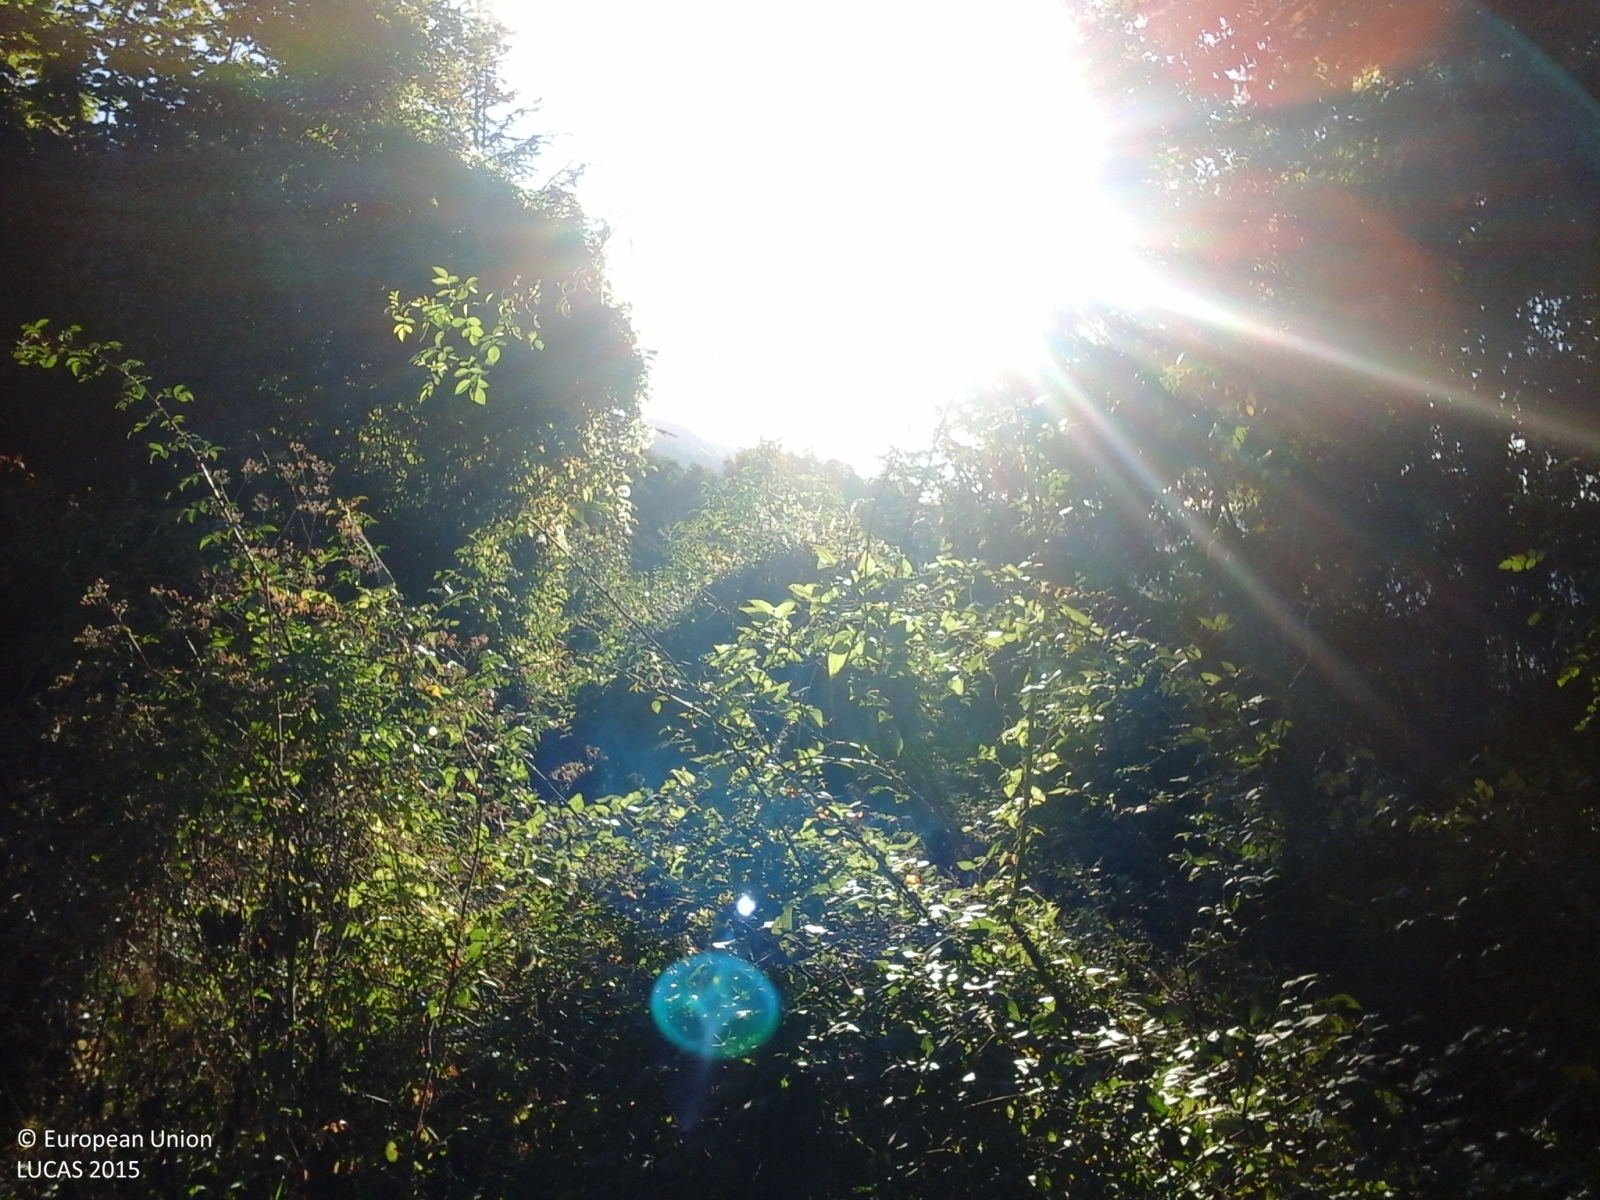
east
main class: Woodland
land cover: Broadleaved woodland
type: thermophilous deciduous forest
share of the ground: > 75 %
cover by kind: broadleaved forest trees 70 %, shrubs 15 %, herbaceous plants 10 %, coniferous forest trees 5 %
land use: Forestry
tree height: > 5 m
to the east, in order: Broadleaved woodland; Tracks; Broadleaved woodland
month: October
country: IT
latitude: 44.0756
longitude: 7.8448
